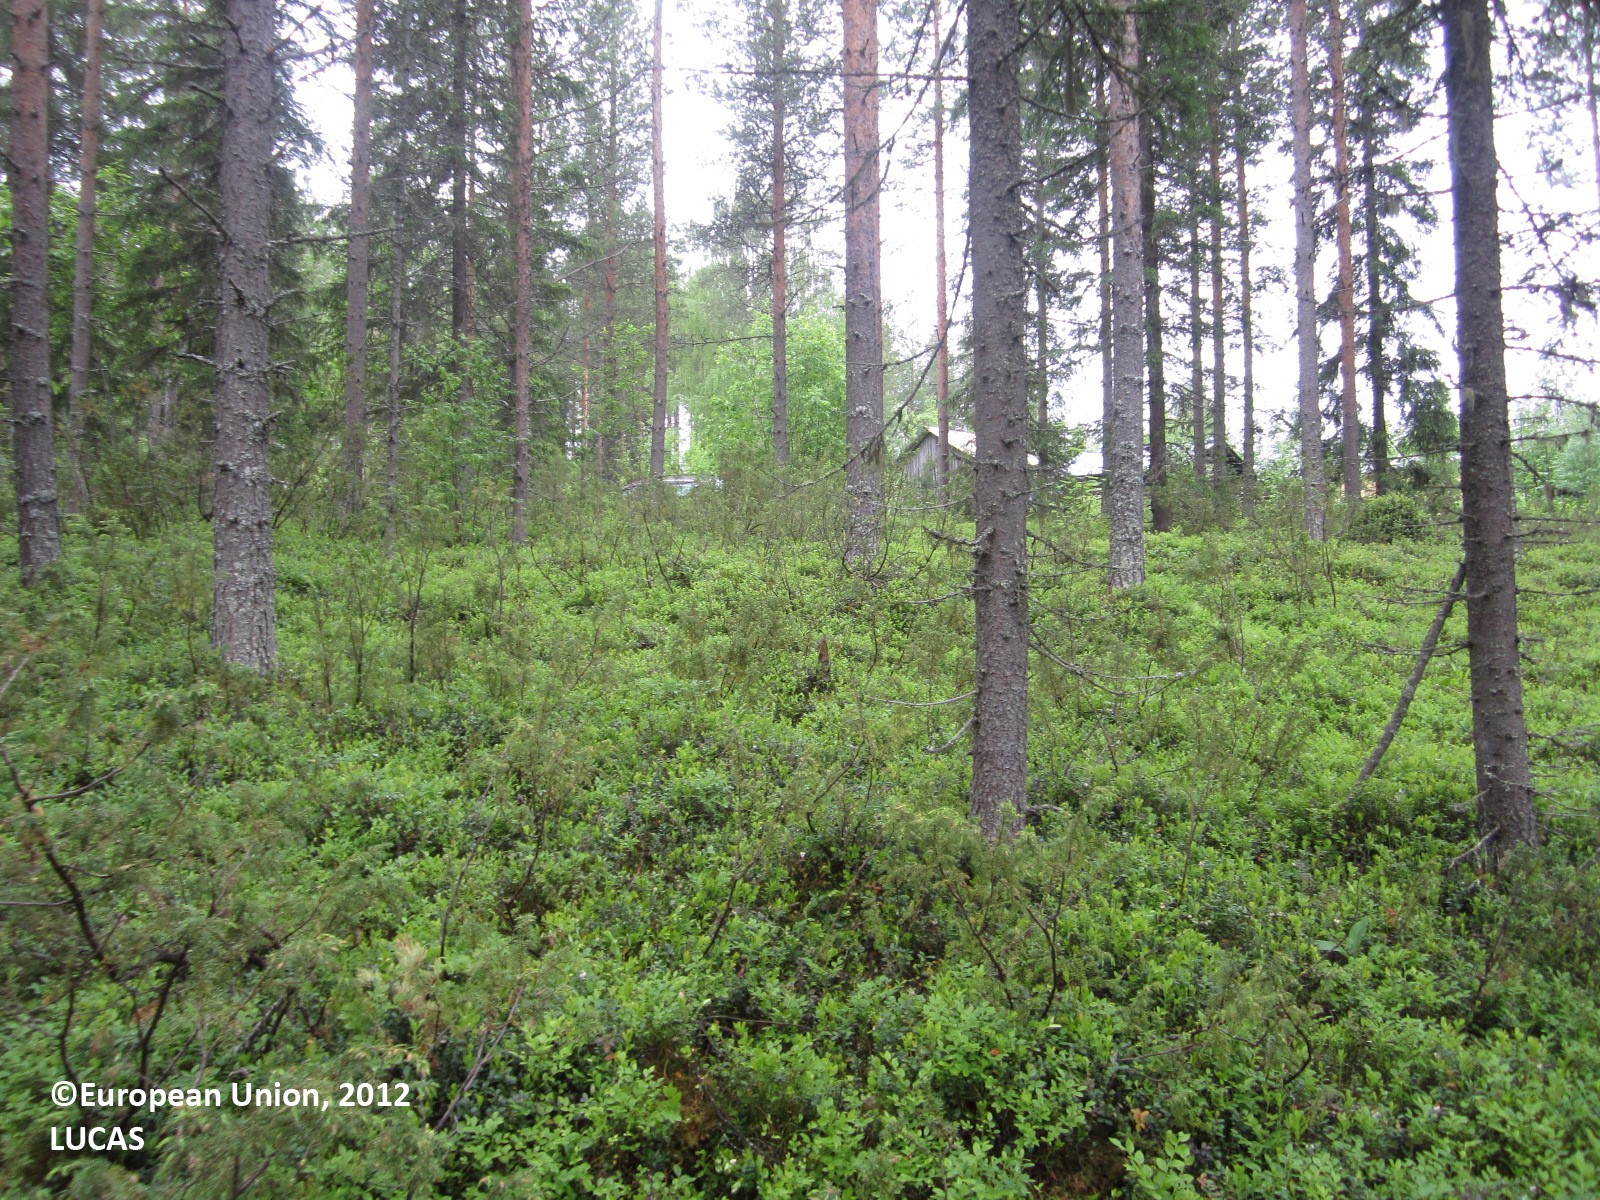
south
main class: Woodland
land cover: Other coniferous woodland
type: boreal forest
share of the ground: > 75 %
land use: Forestry
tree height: > 5 m
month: June
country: FI
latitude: 64.5542
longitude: 29.2044
